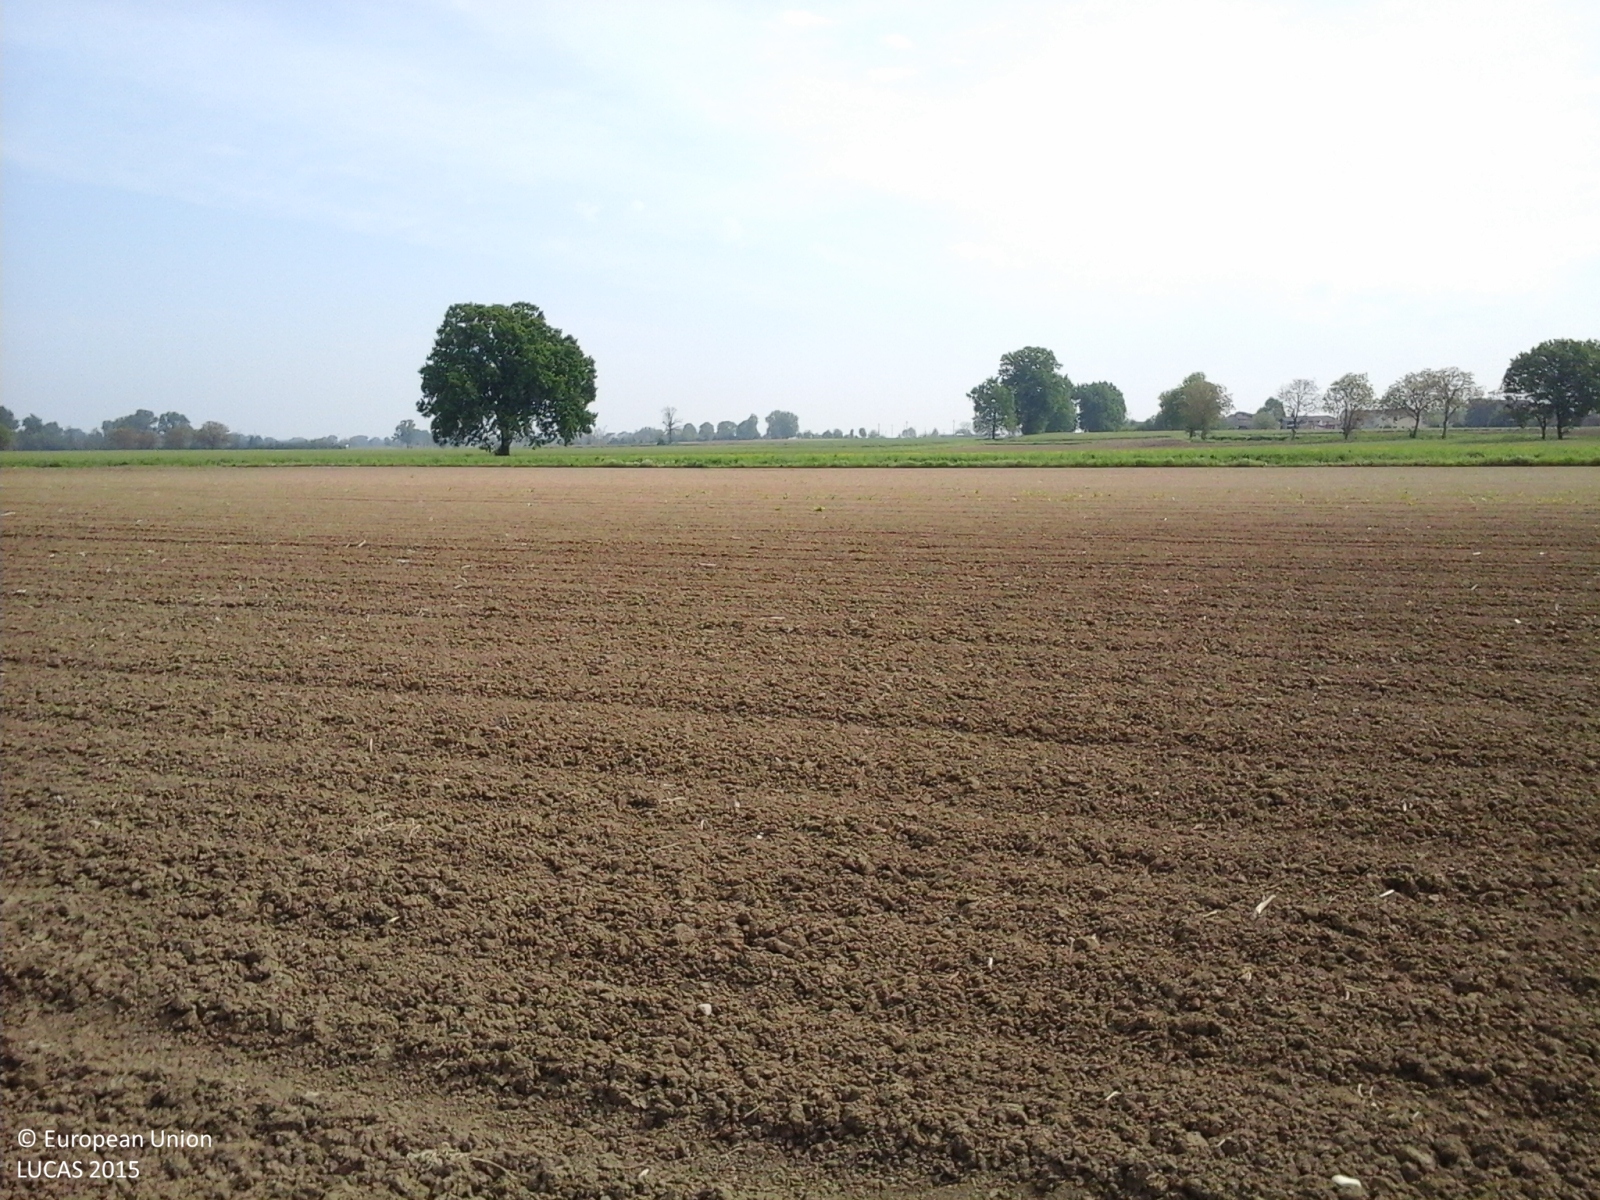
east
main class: Cropland
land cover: Maize
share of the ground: < 10 %
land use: Agriculture (excluding fallow land and kitchen gardens)
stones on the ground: < 10 %
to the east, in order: Maize; Ditches and canals; Other leguminous and mixtures for fodder; Lines of trees; Ditches and canals; Maize
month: April
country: IT
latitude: 45.0519
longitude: 9.3790
